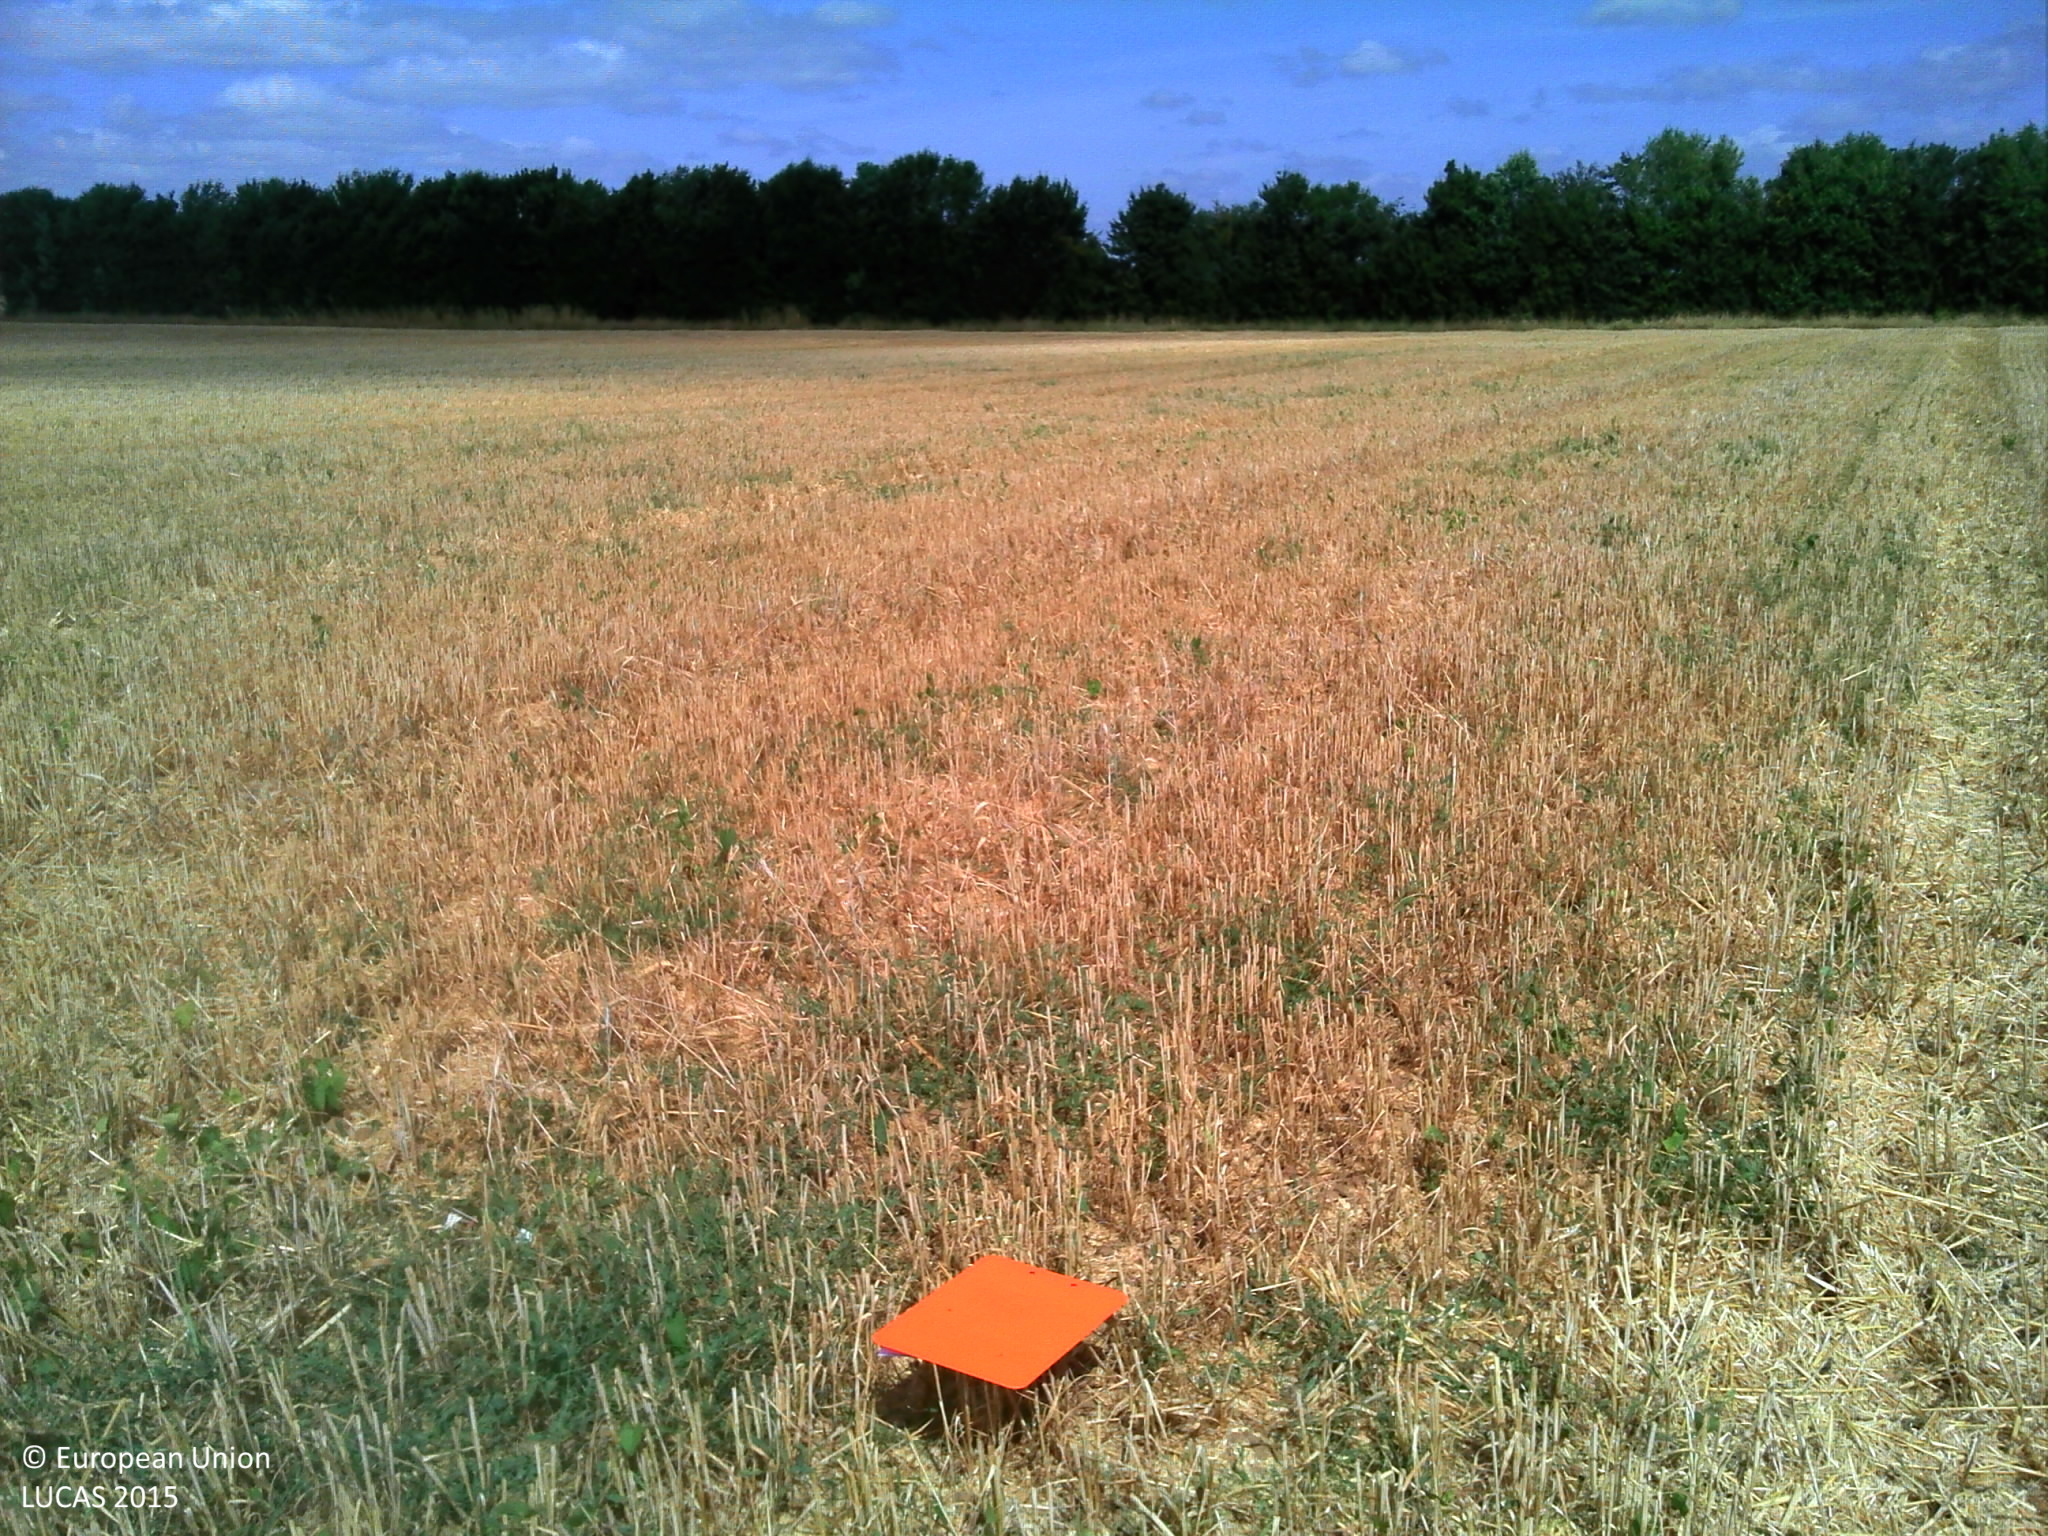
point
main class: Cropland
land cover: Durum wheat
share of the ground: > 75 %
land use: Agriculture (excluding fallow land and kitchen gardens)
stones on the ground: 10 - 25 %
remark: Harvested field
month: July
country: FR
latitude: 45.4955
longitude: -0.6054
